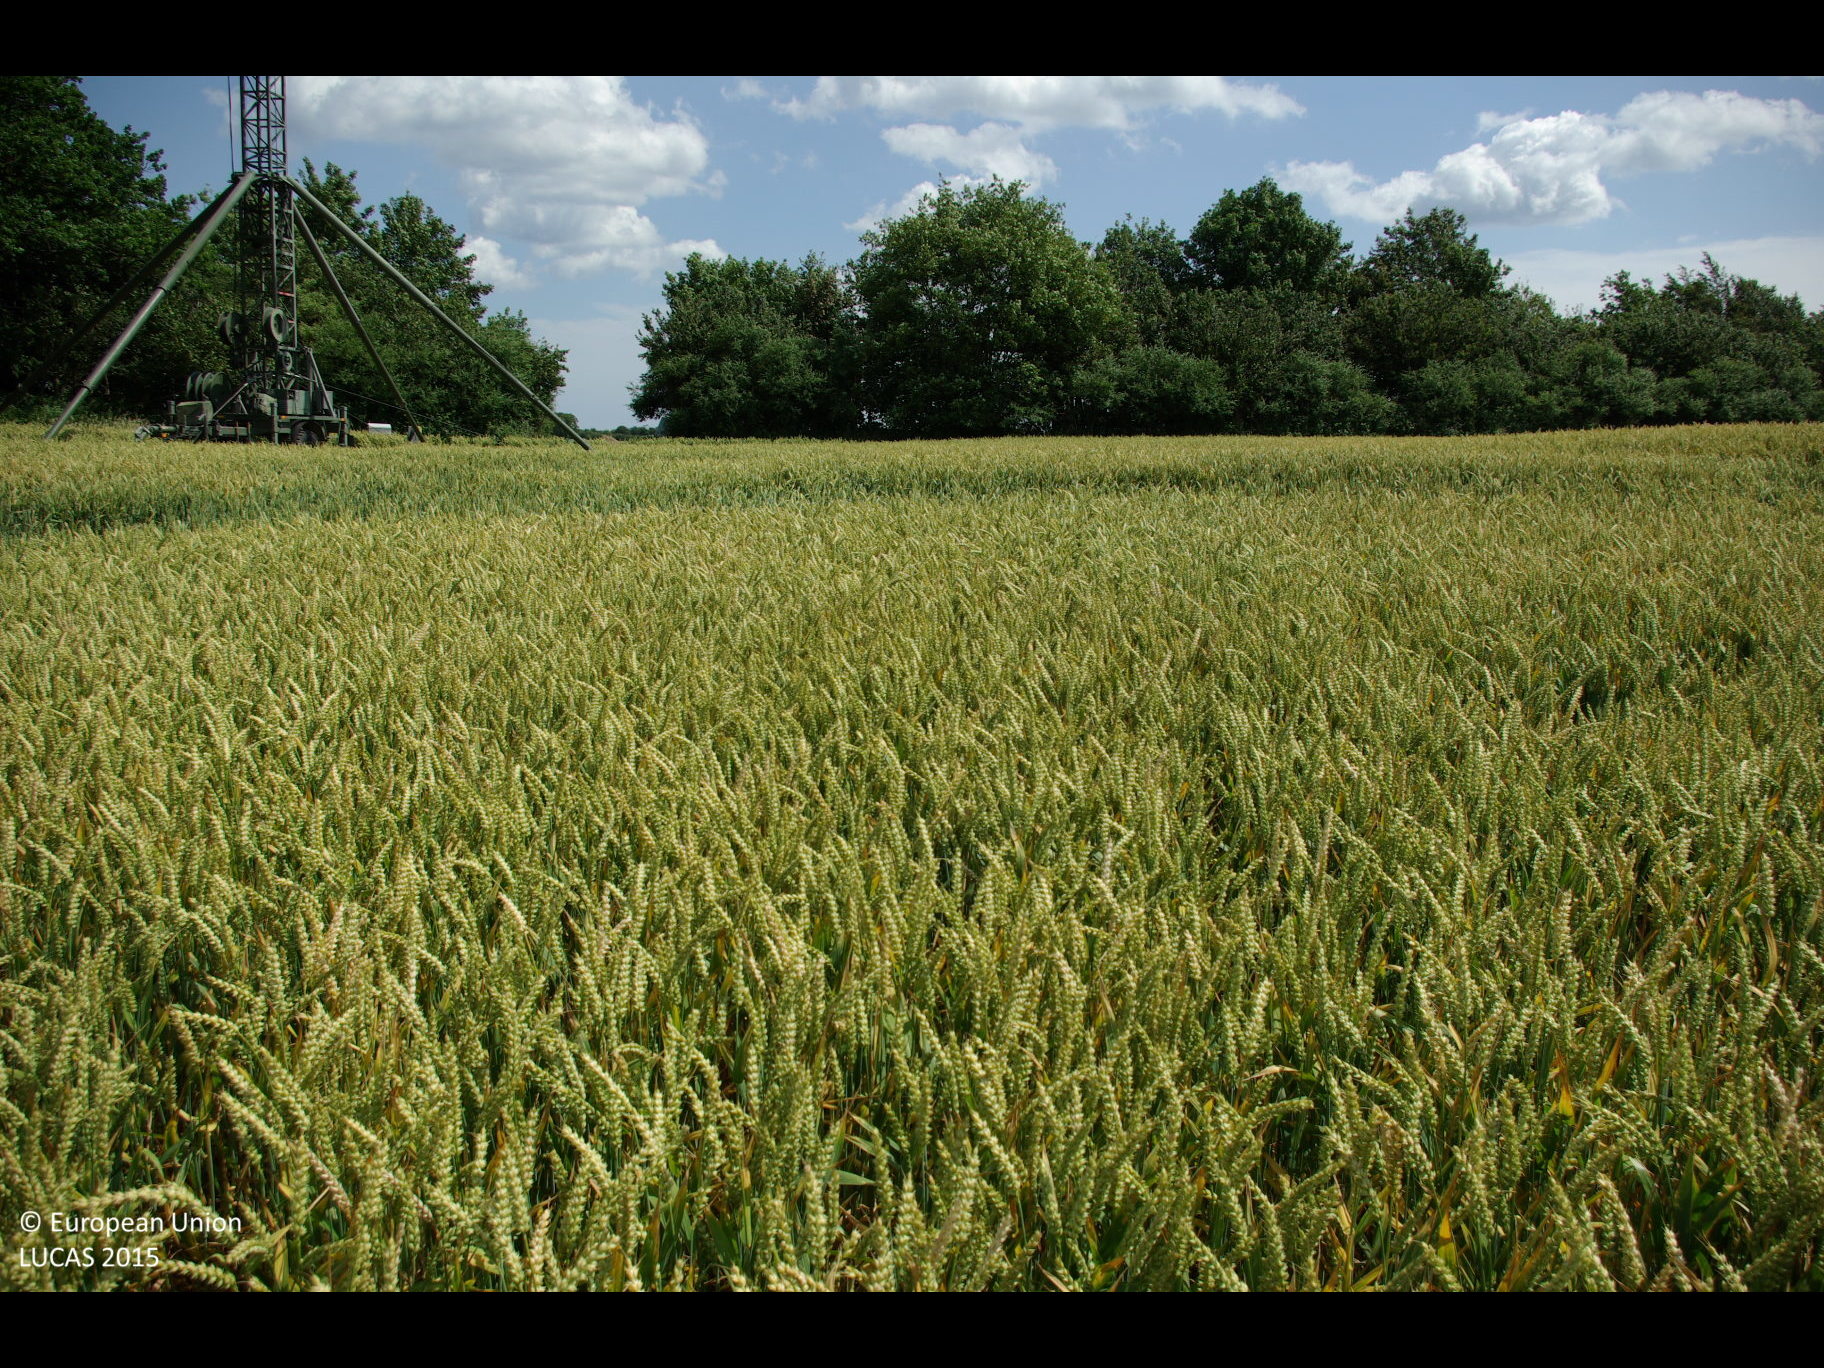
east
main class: Cropland
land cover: Common wheat
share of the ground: > 75 %
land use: Agriculture (excluding fallow land and kitchen gardens)
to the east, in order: Common wheat; Shruby margins; Broadleaved woodland; Spontaneously vegetated surfaces; Tracks; Shruby margins; Maize
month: July
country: DE
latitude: 54.5341
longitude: 9.9537
